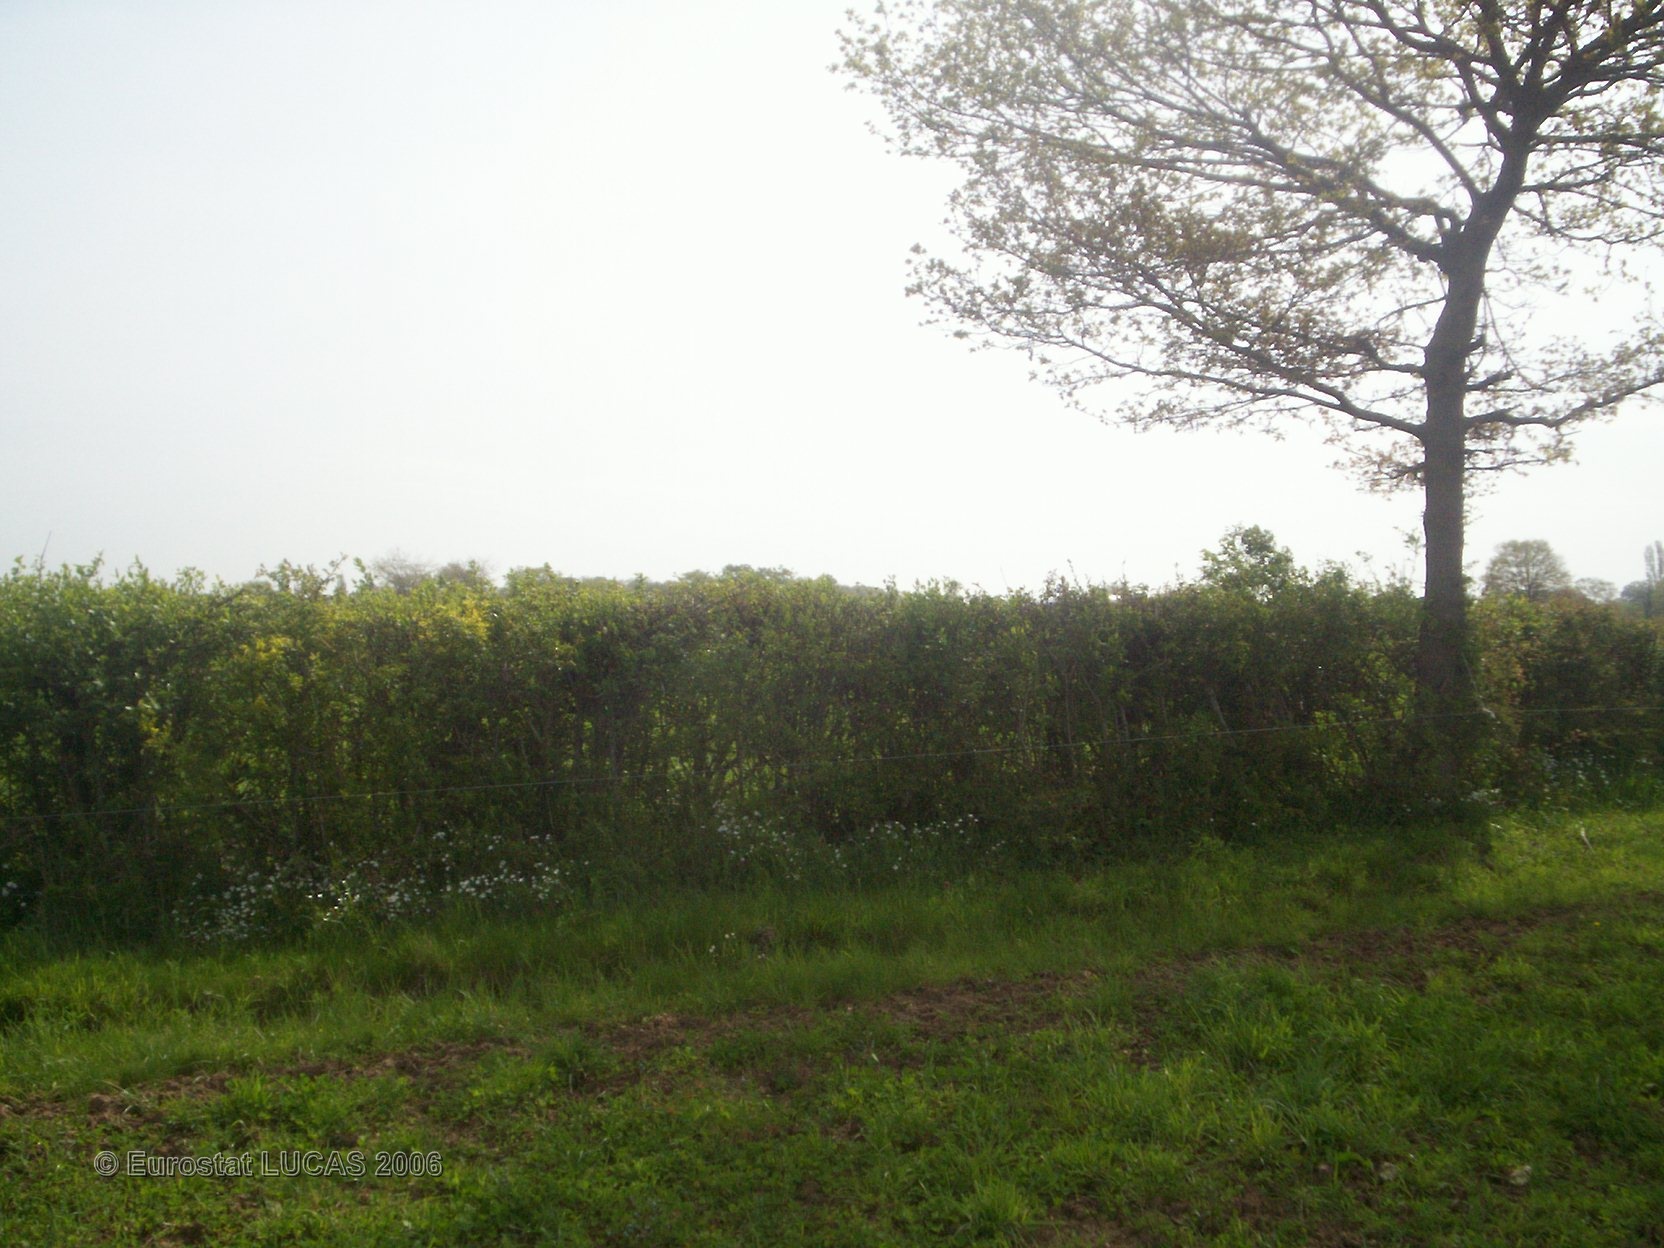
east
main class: Grassland
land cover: Grassland without tree/shrub cover
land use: Agriculture (excluding fallow land and kitchen gardens)
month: May
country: FR
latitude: 46.5472
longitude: 3.1507
